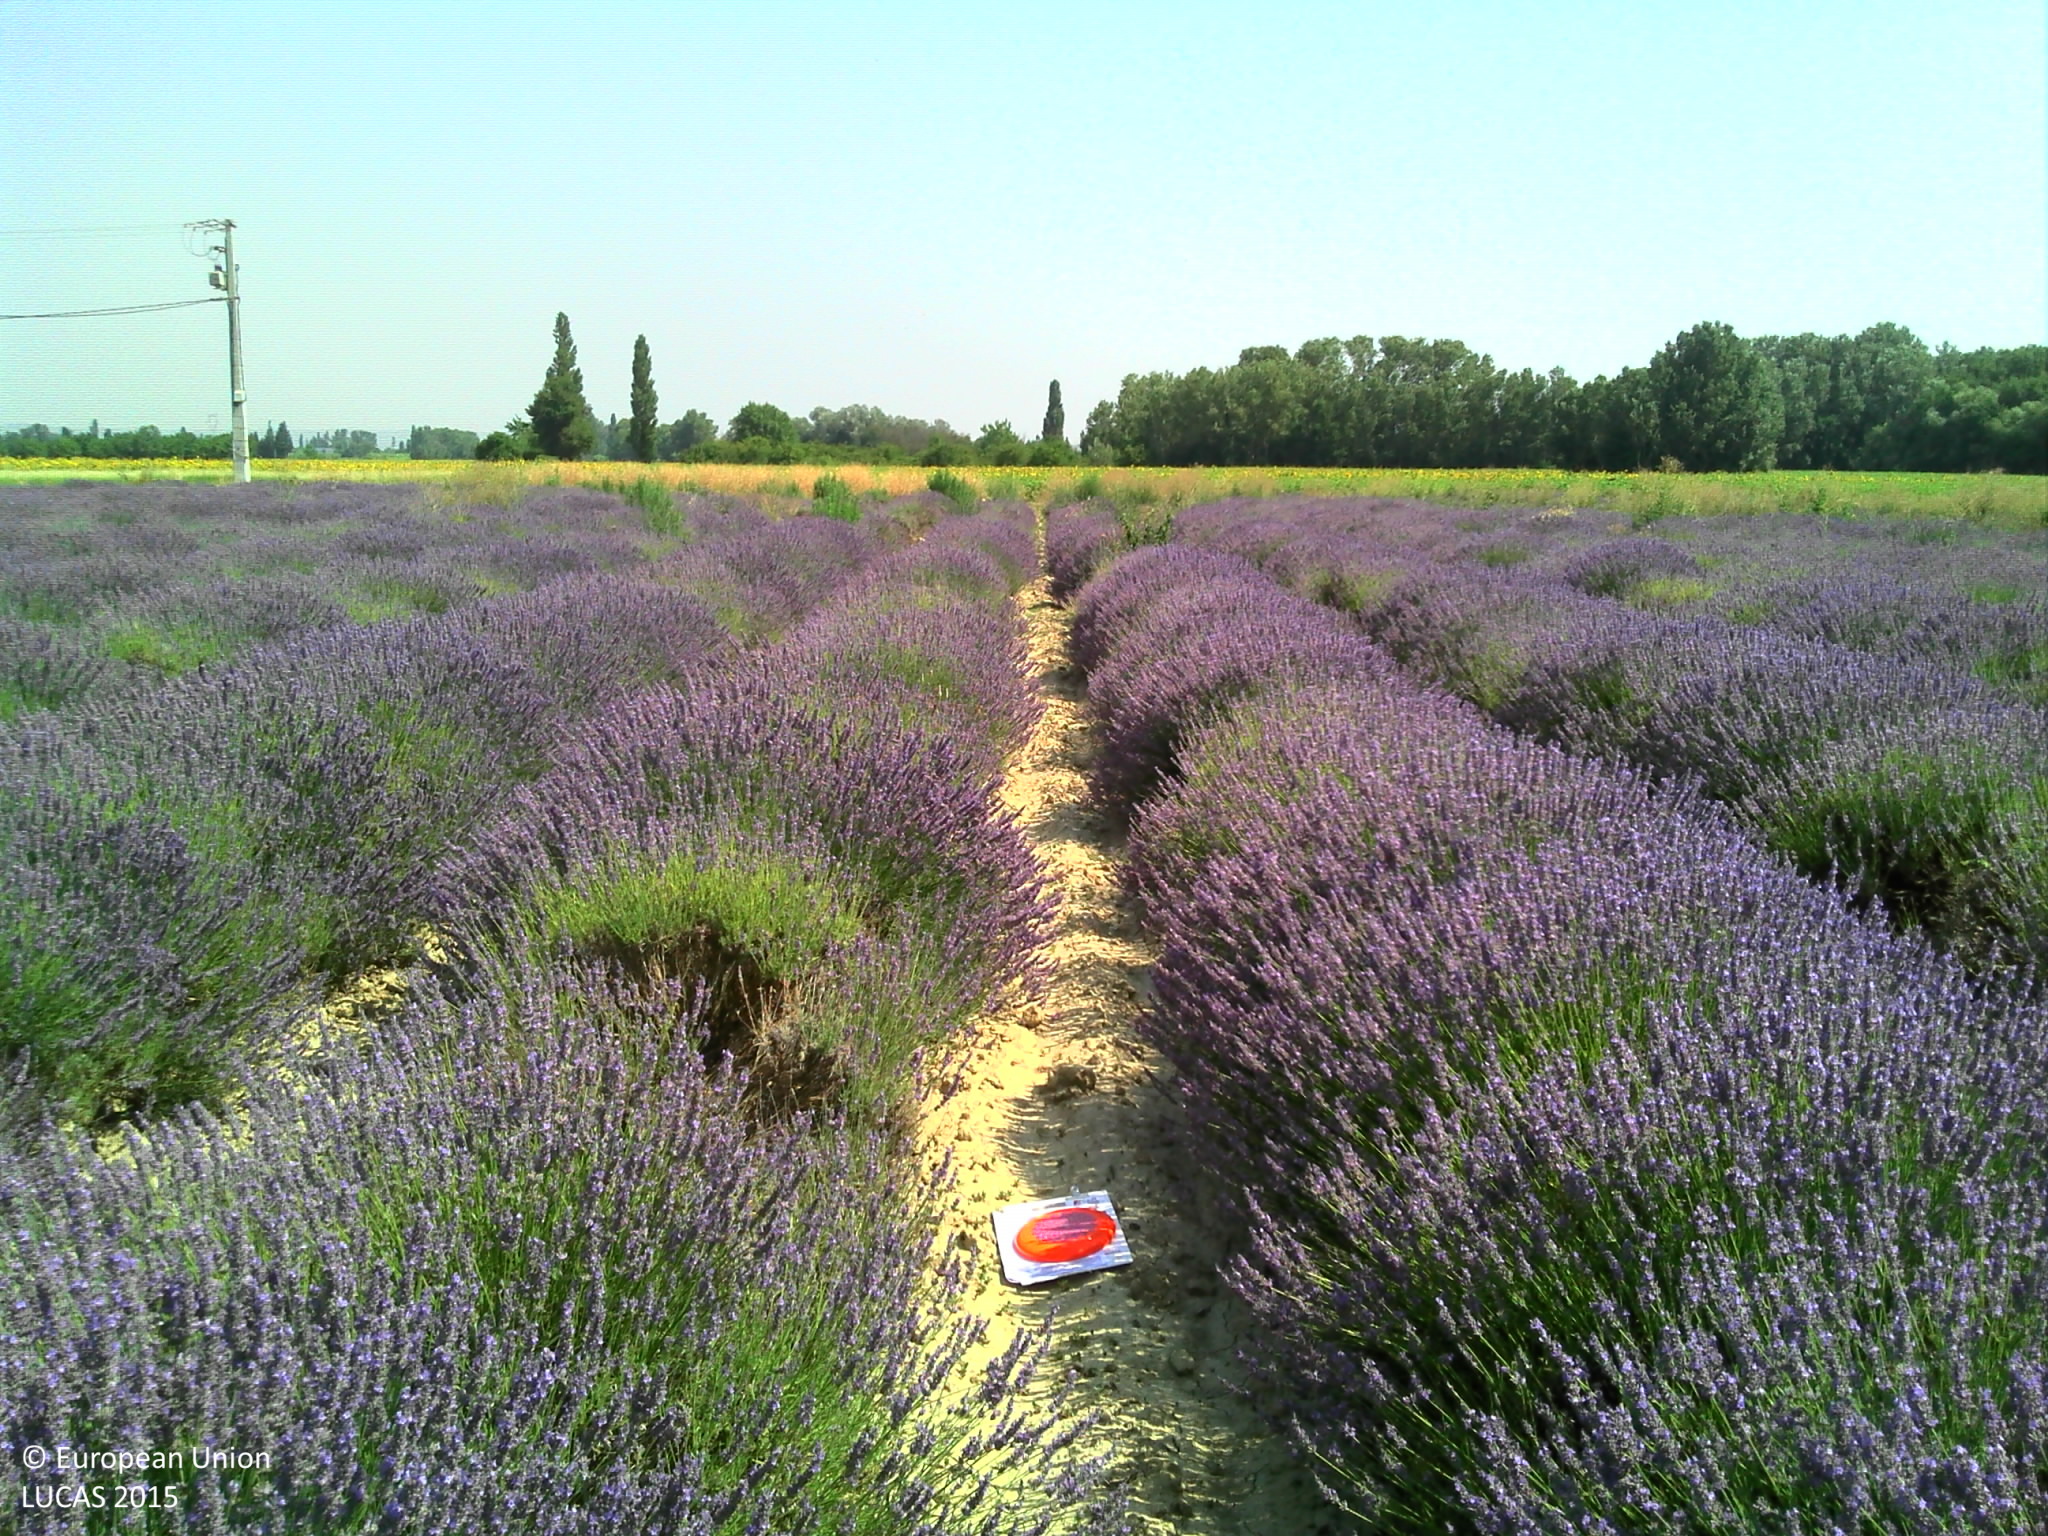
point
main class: Cropland
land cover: Permanent industrial crops
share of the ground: > 75 %
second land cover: Other bare soil
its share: > 75 %
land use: Agriculture (excluding fallow land and kitchen gardens)
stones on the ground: < 10 %
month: July
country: FR
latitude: 44.2865
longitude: 4.6817
